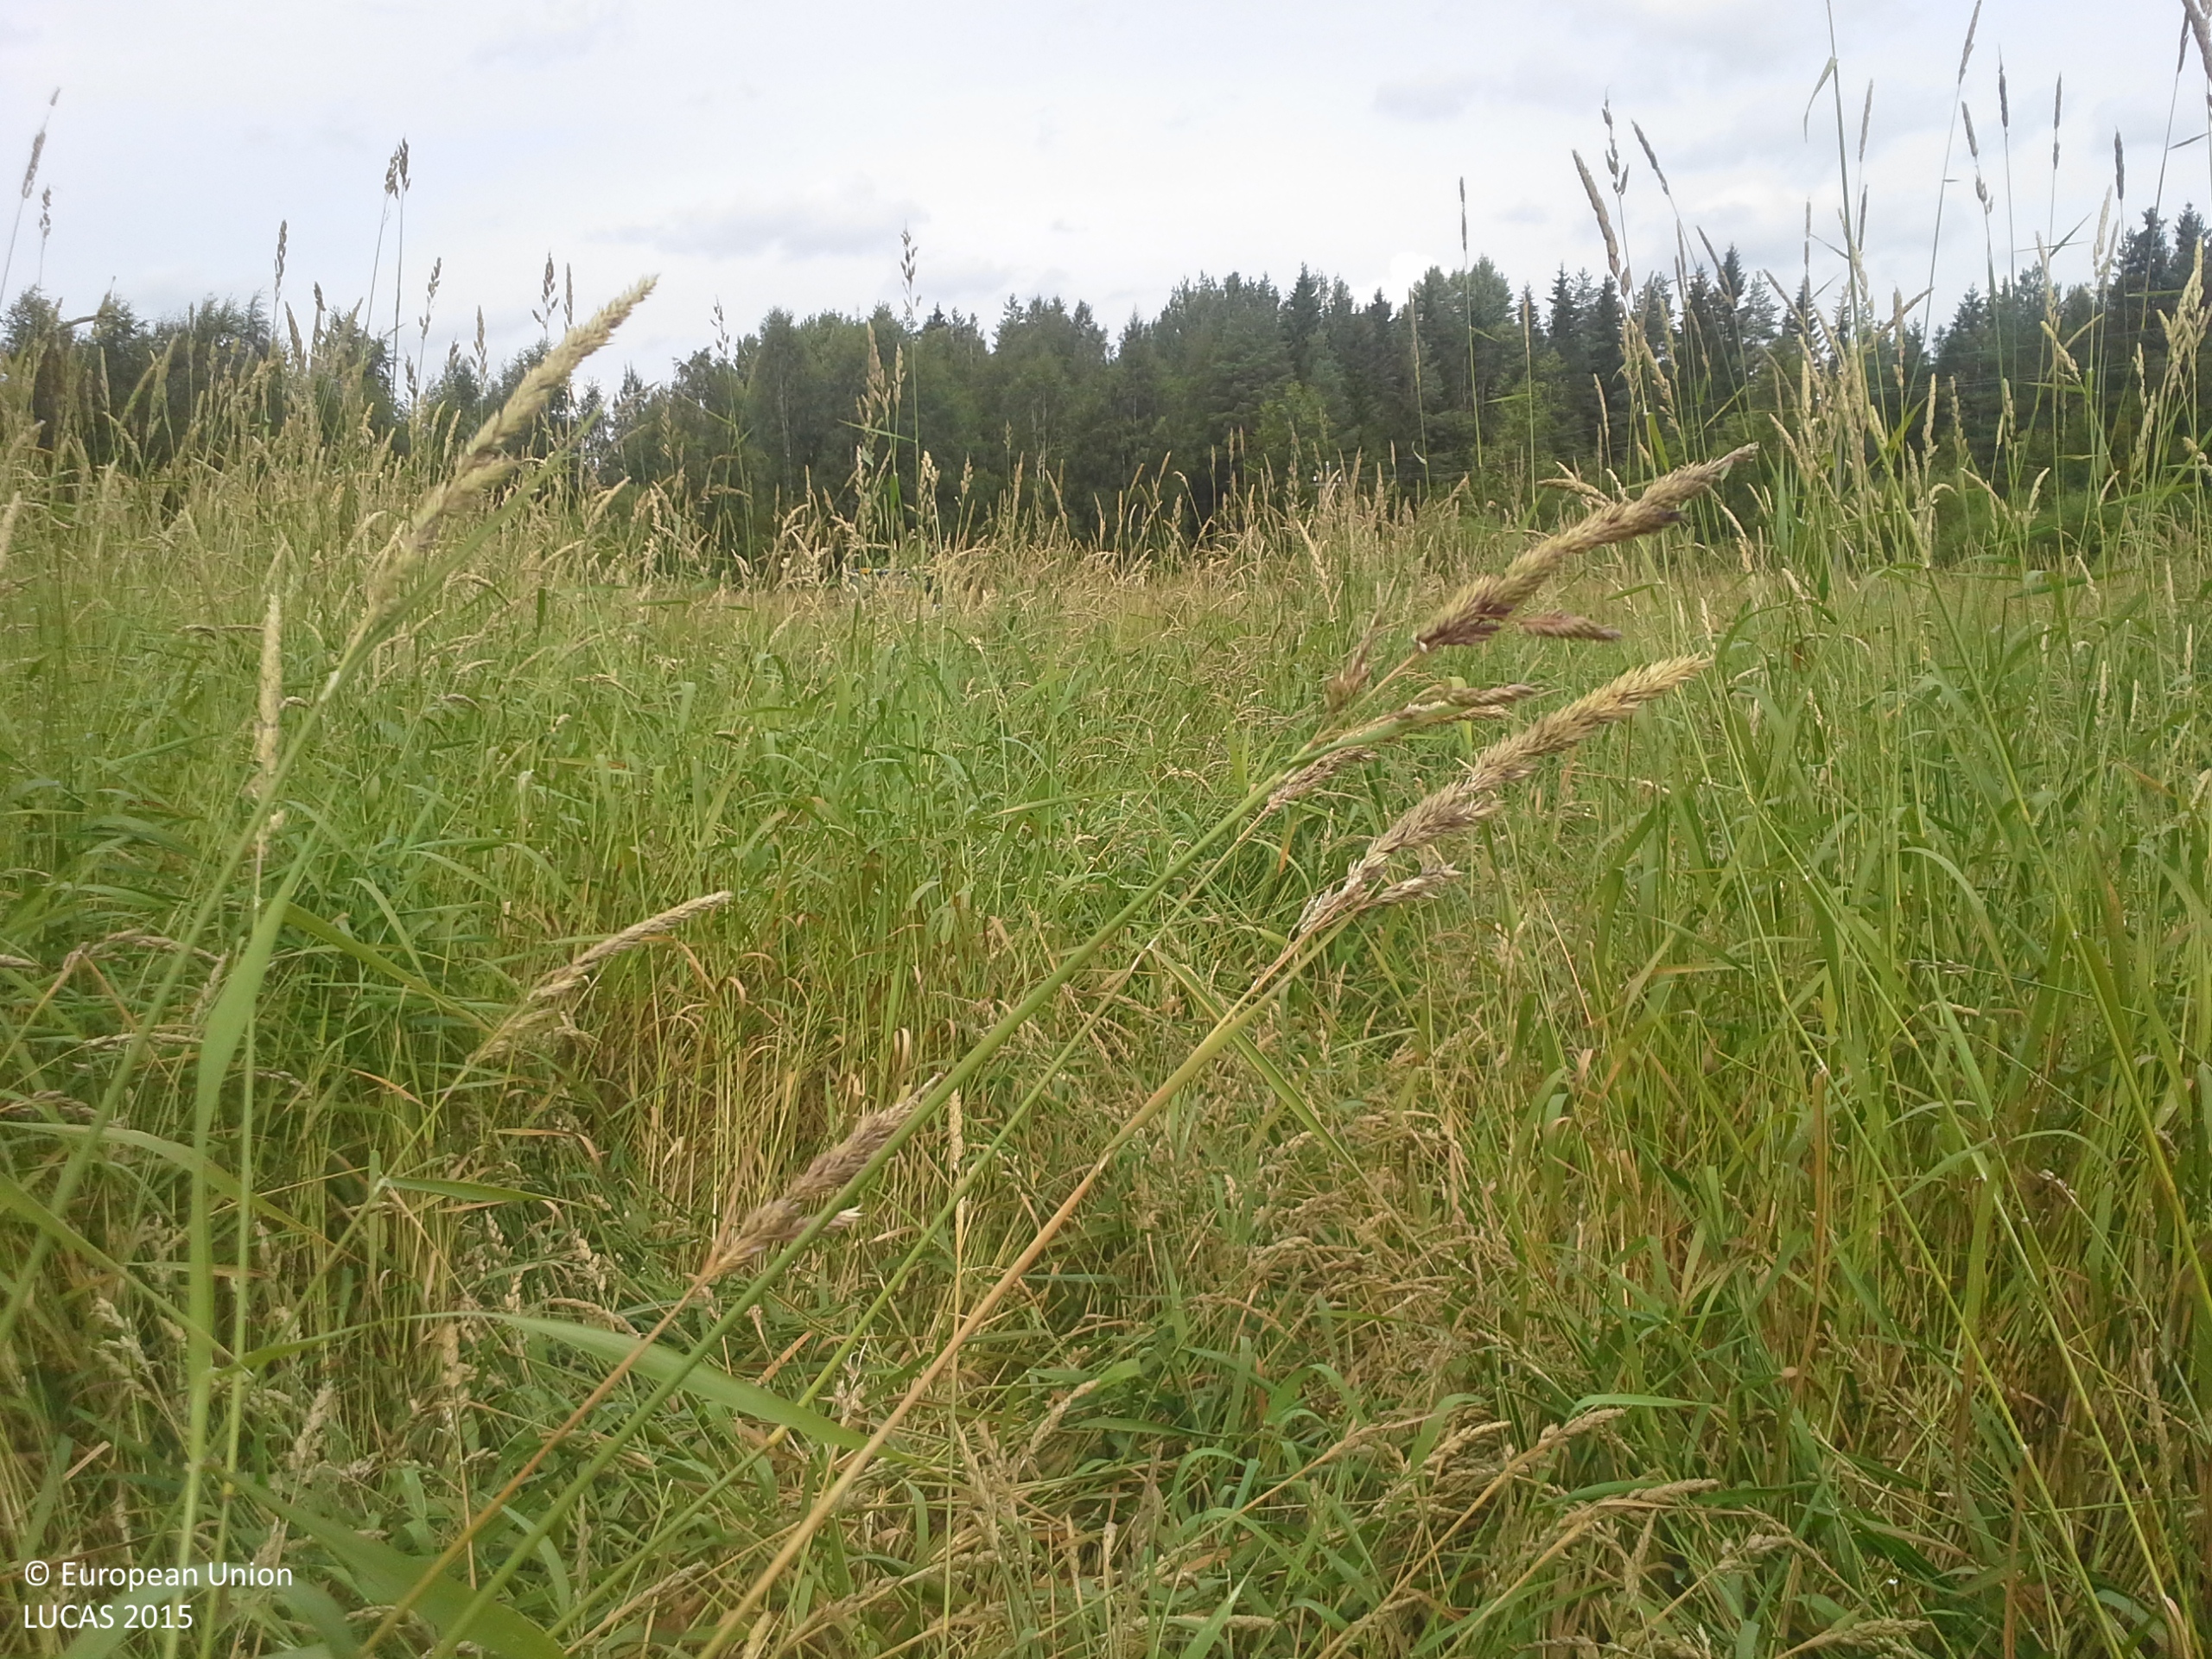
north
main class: Cropland
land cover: Temporary grasslands
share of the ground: > 75 %
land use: Agriculture (excluding fallow land and kitchen gardens)
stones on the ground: < 10 %
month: August
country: FI
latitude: 63.1155
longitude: 22.9210
